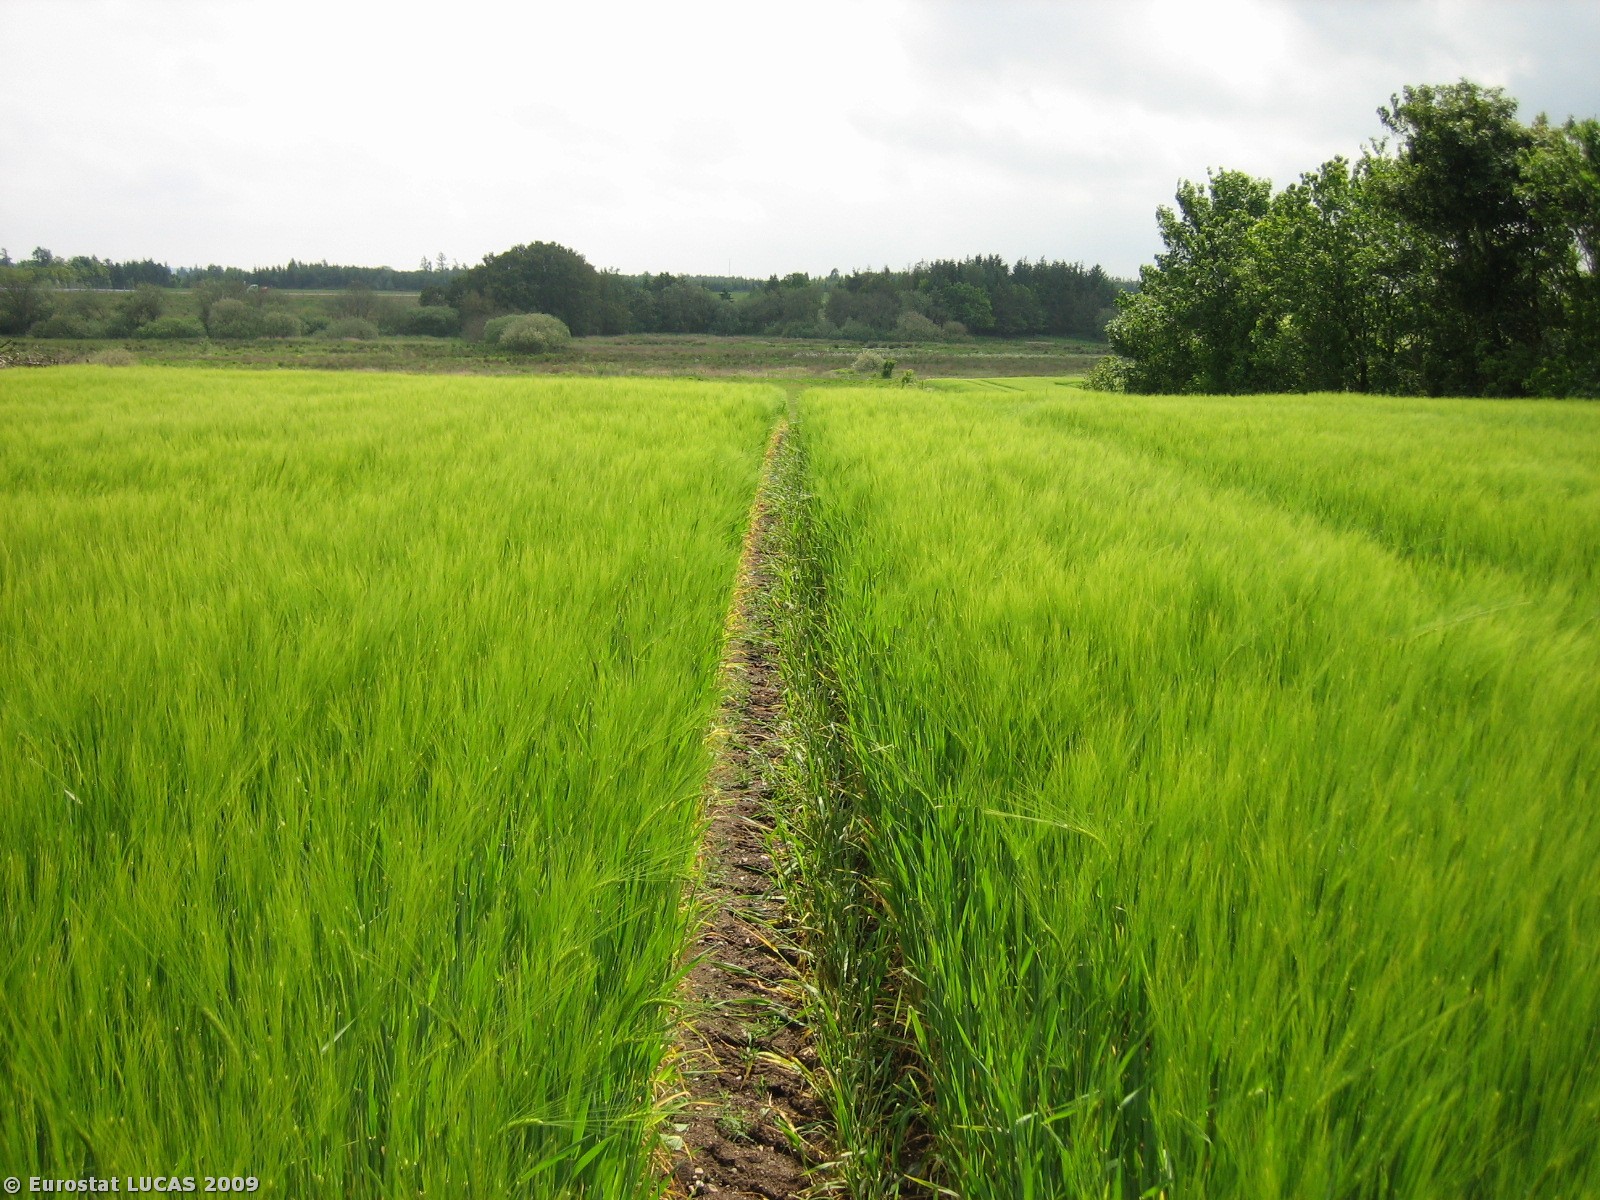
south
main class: Cropland
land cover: Barley
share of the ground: > 75 %
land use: Agriculture (excluding fallow land and kitchen gardens)
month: May
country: DK
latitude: 55.8079
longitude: 9.2190
